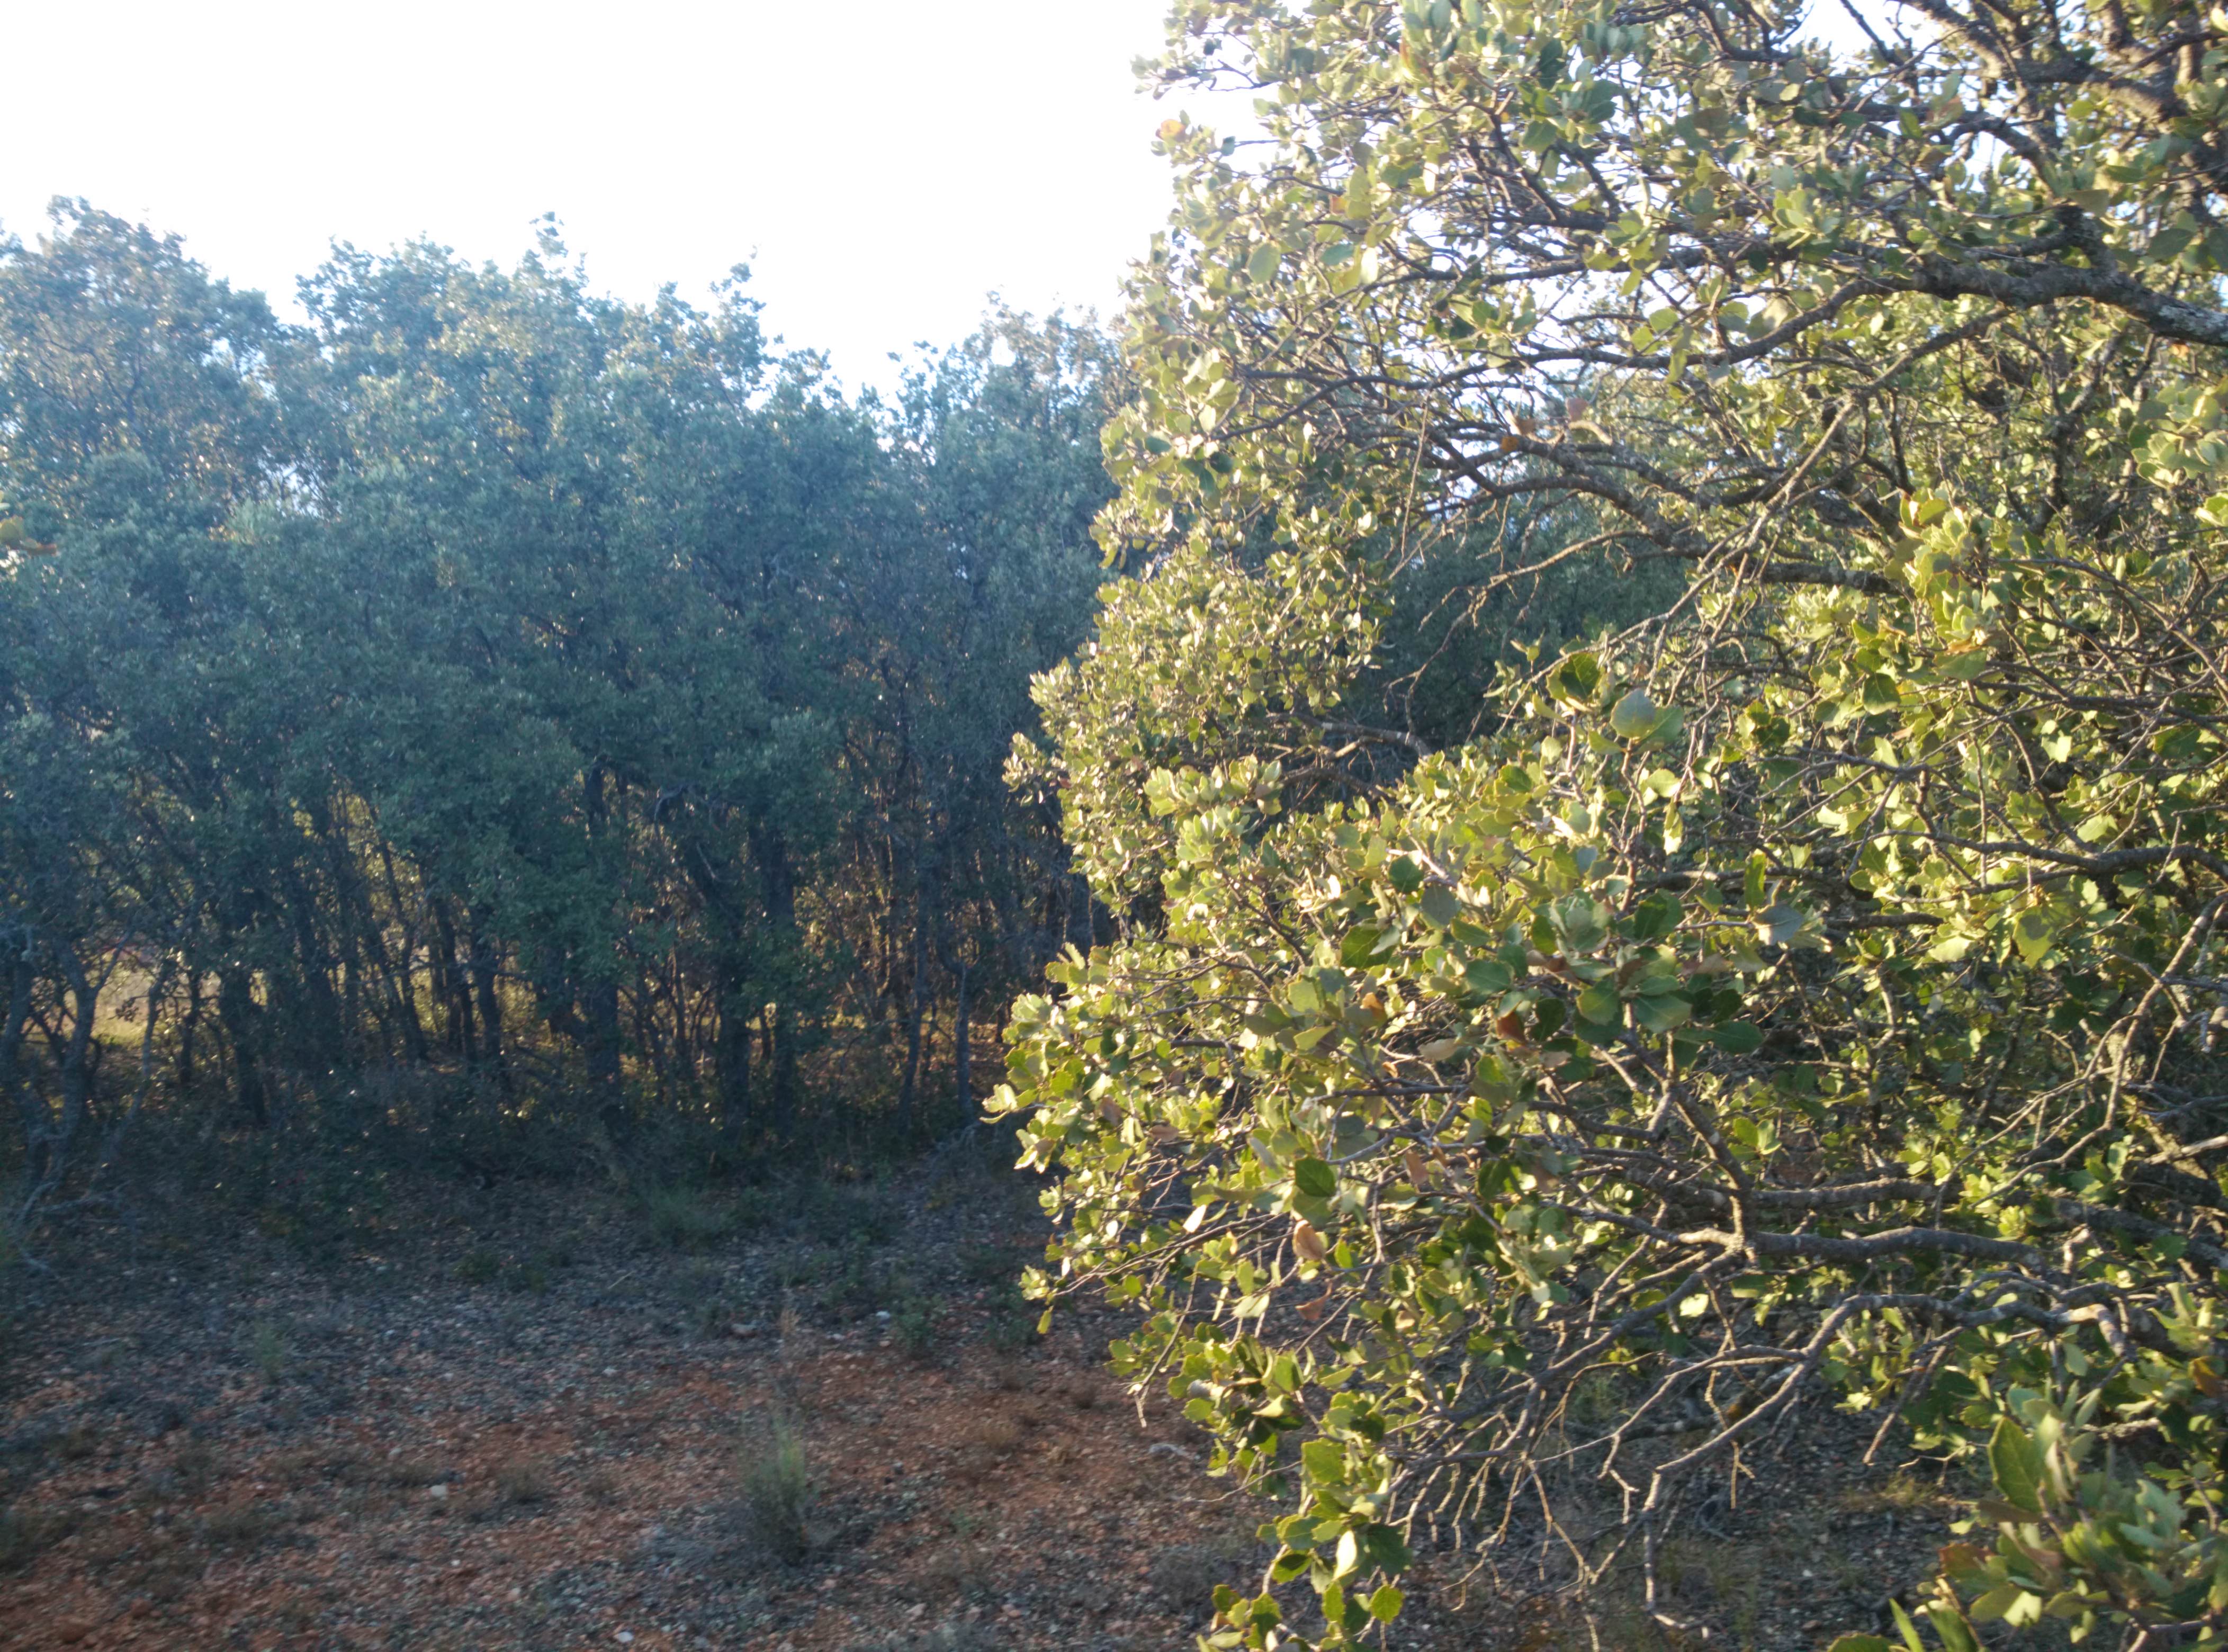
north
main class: Woodland
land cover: Broadleaved woodland
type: thermophilous deciduous forest
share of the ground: > 75 %
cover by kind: broadleaved forest trees 70 %, unconsolidated bare surface 25 %, herbaceous plants 5 %
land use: Semi-natural and natural areas not in use
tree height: > 5 m
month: July
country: ES
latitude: 40.9697
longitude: -2.7353
